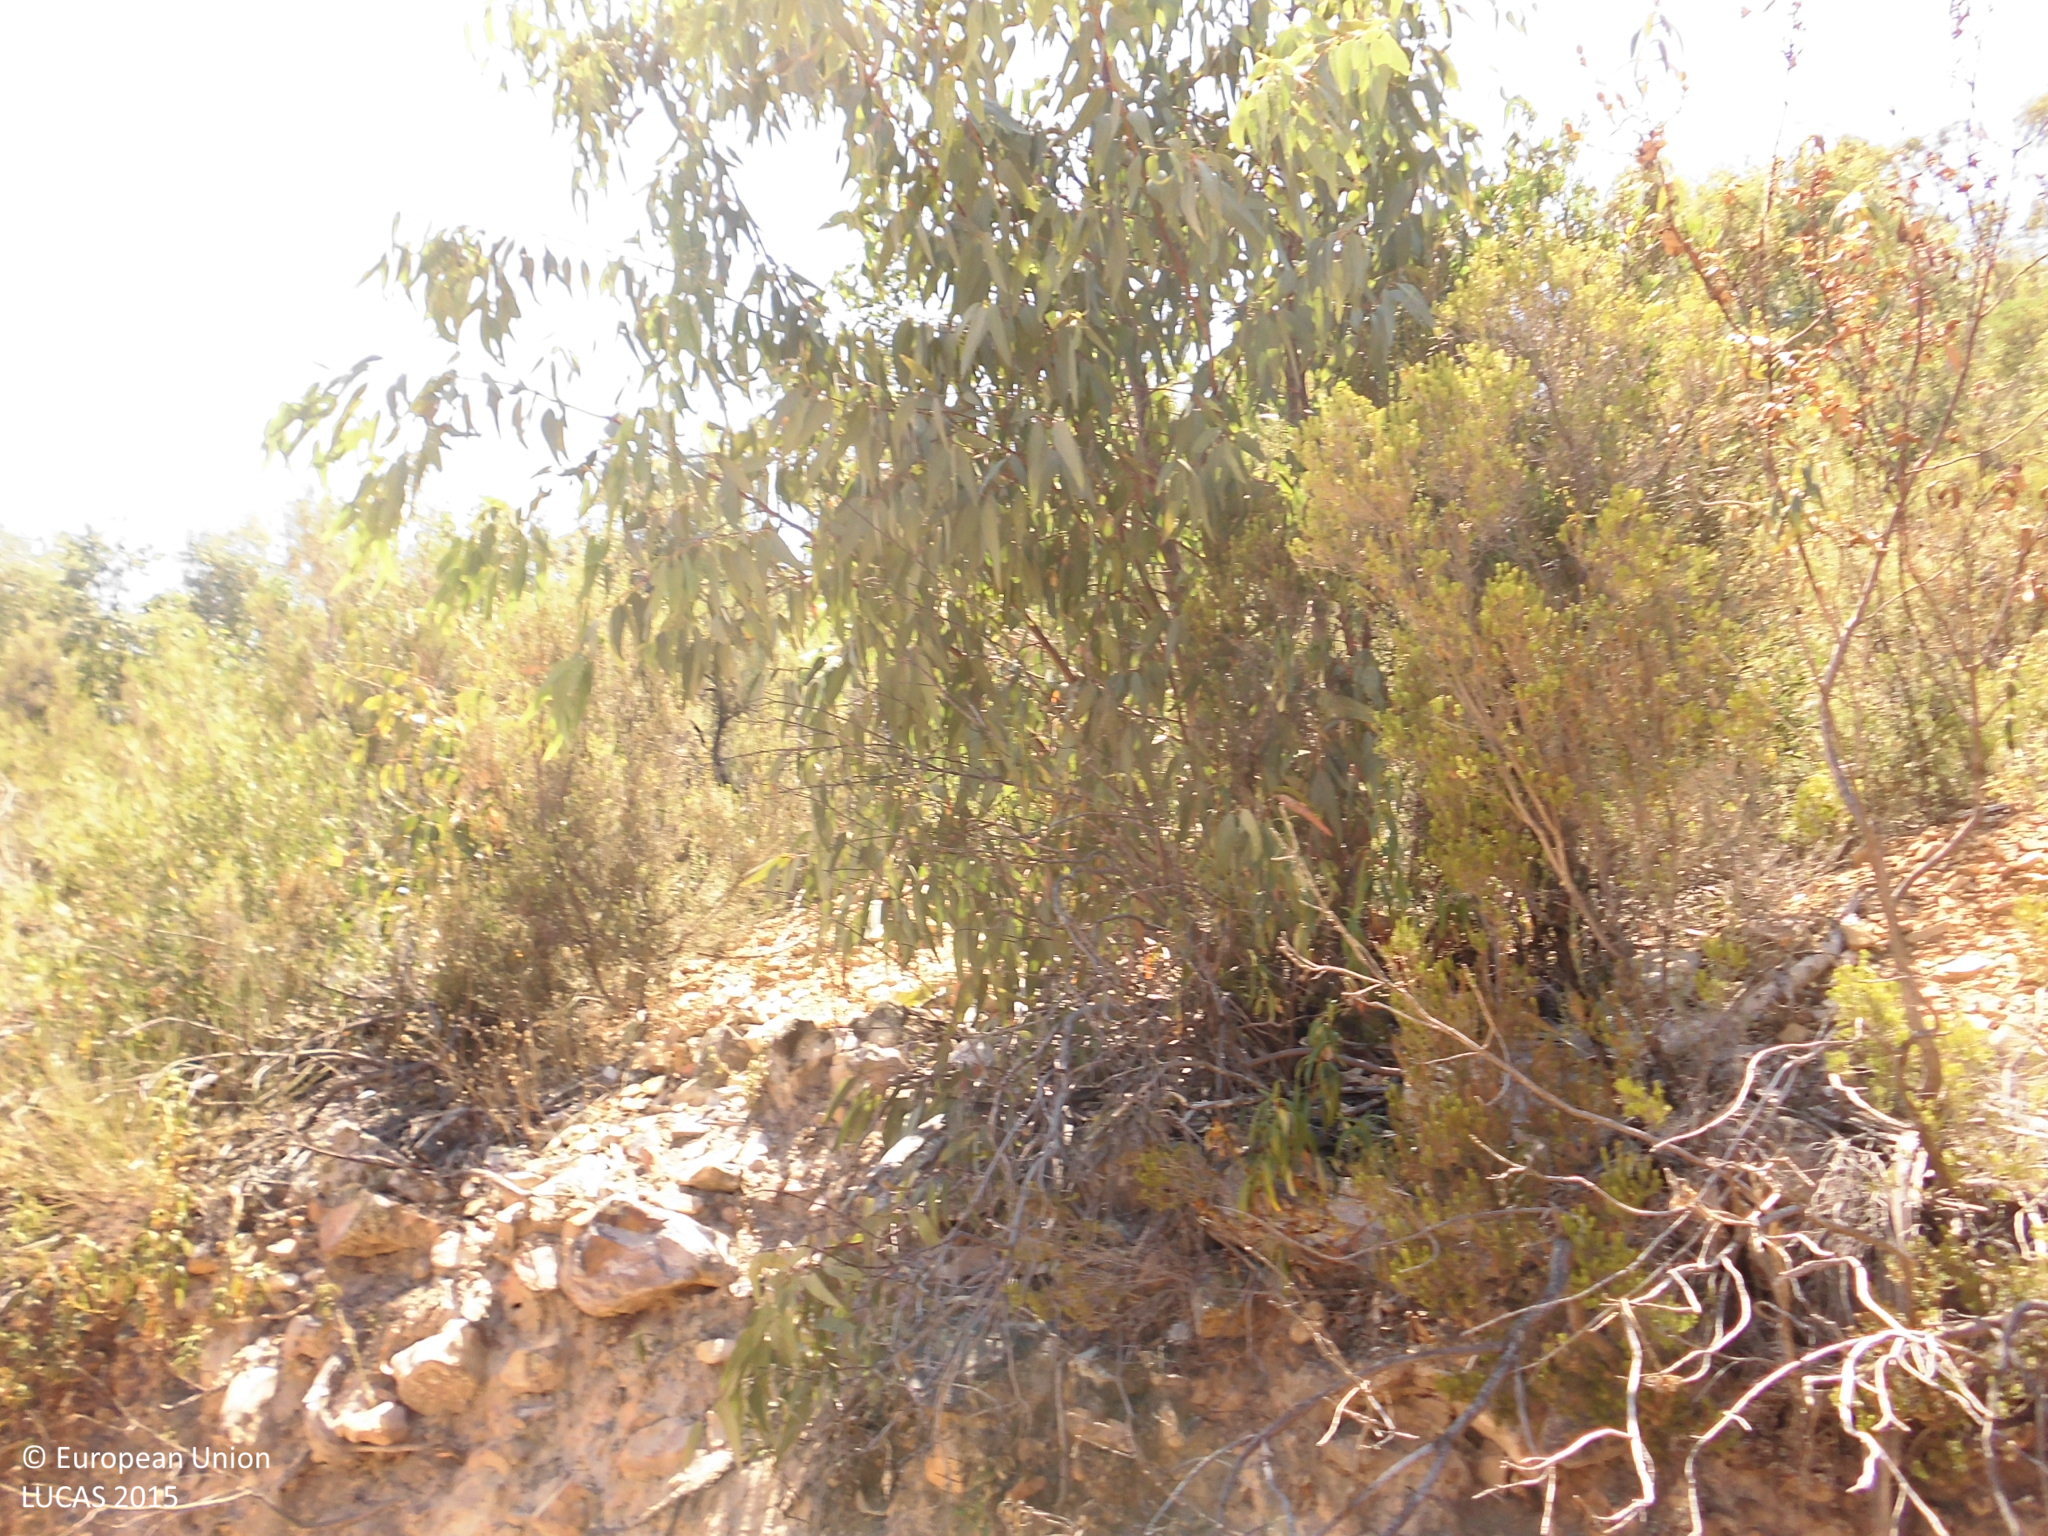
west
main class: Woodland
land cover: Broadleaved woodland
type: exotic forest
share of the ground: 10 - 25 %
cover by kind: shrubs 60 %, broadleaved forest trees 20 %, herbaceous plants 20 %
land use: Forestry
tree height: > 5 m
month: July
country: ES
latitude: 39.7064
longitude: -5.3908
